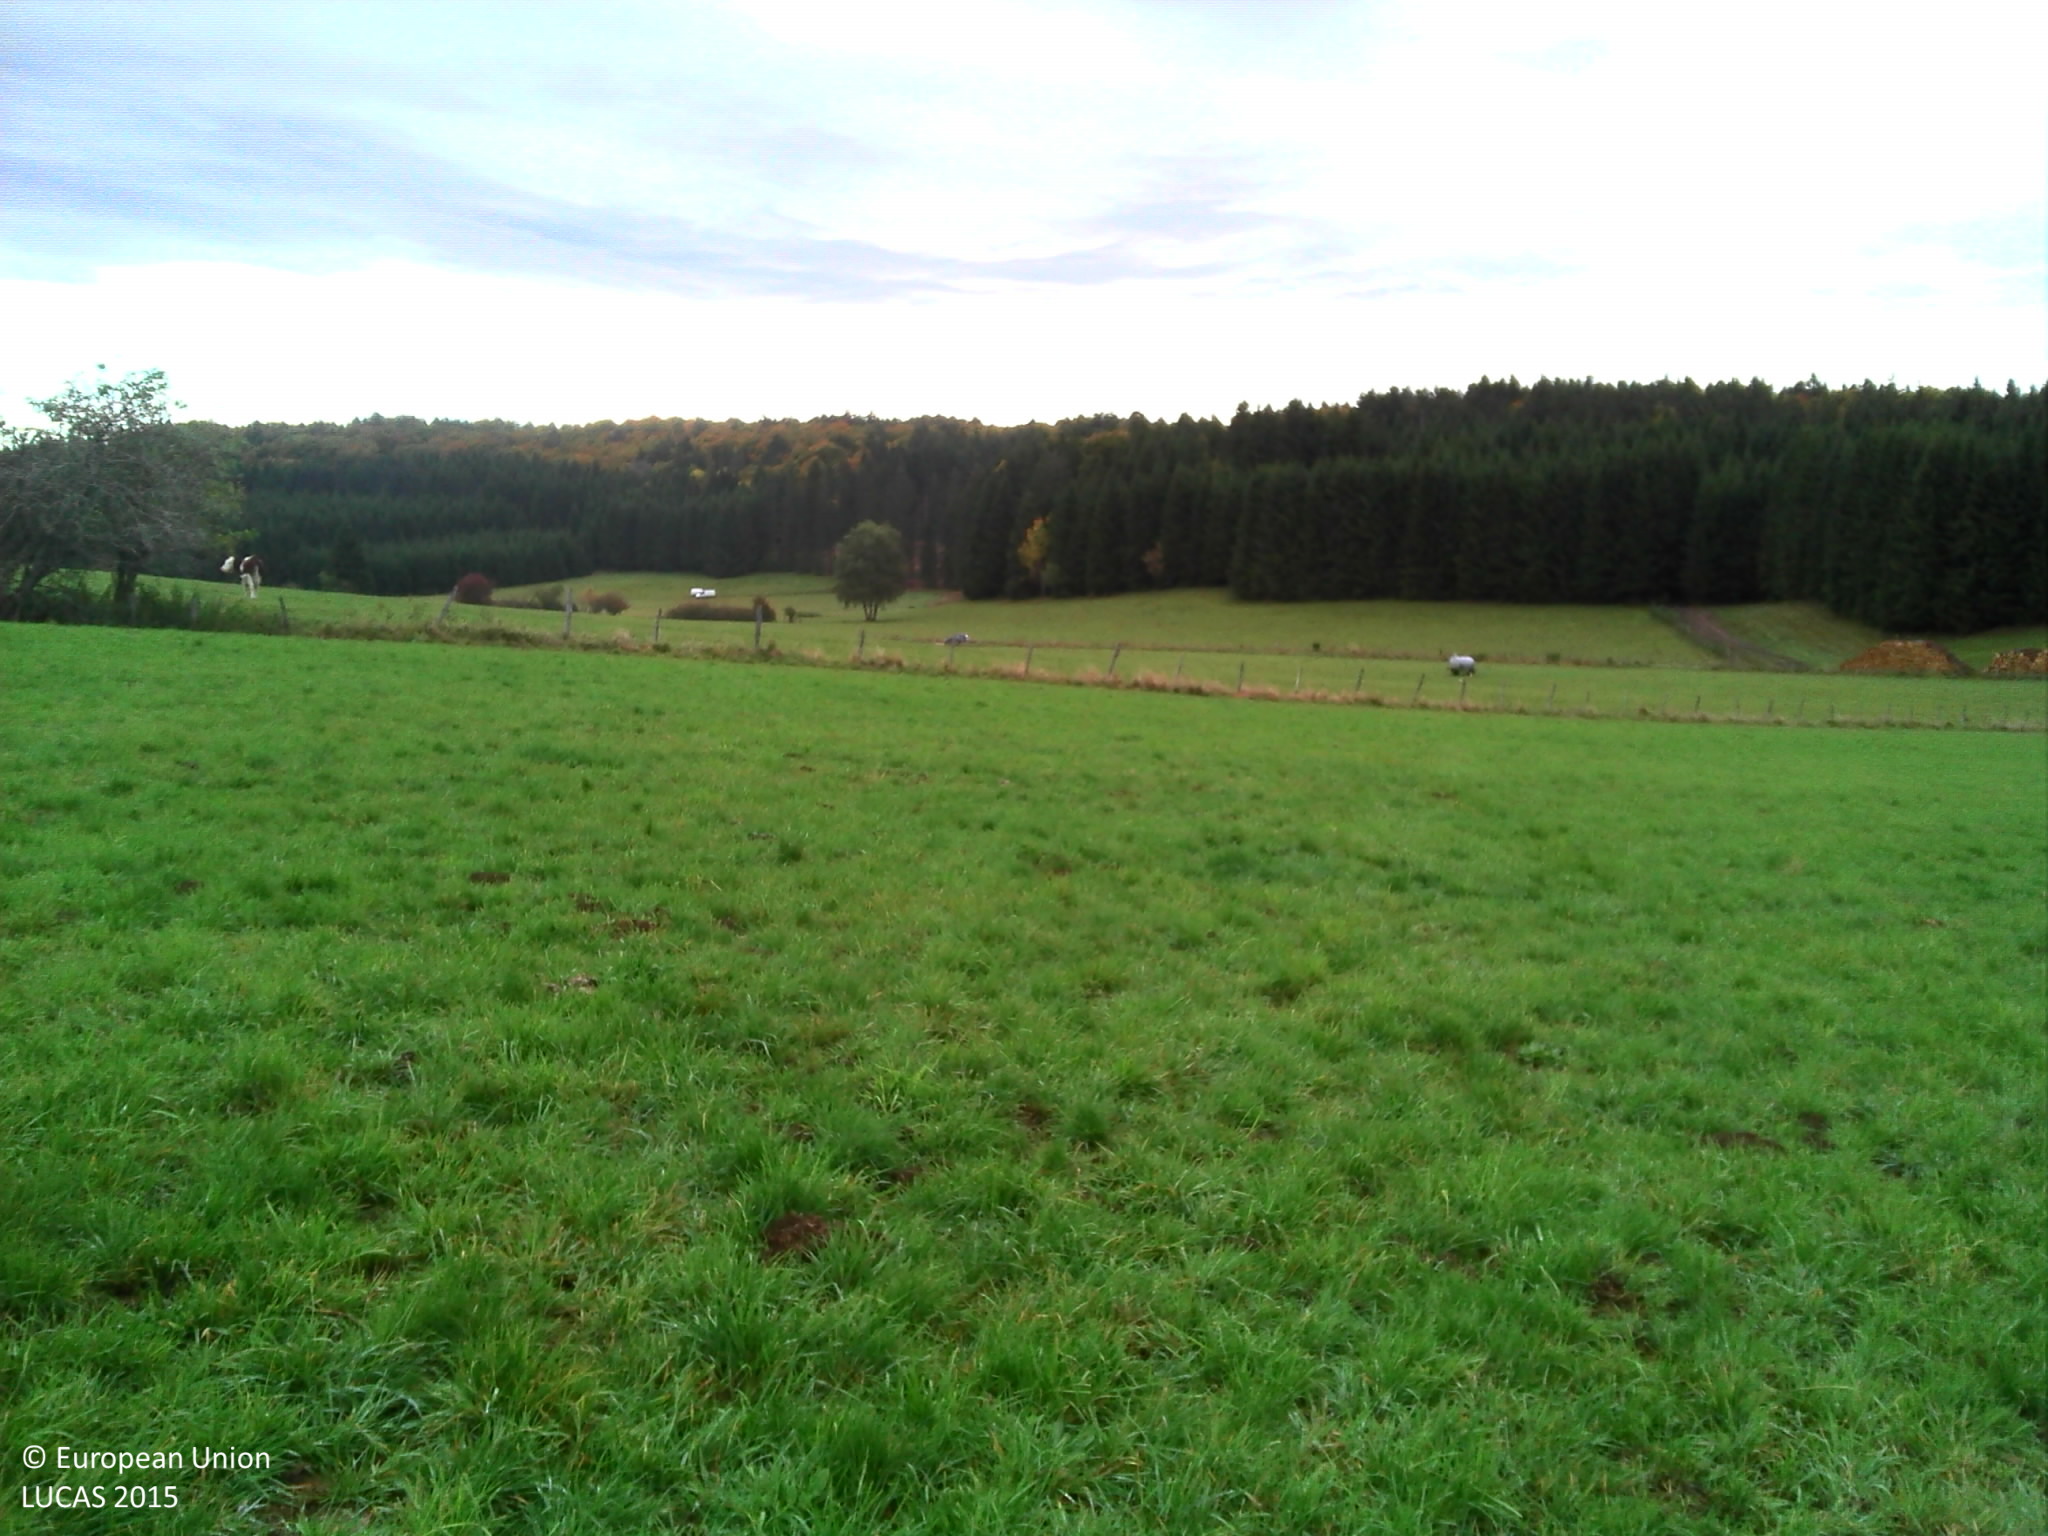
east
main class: Grassland
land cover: Grassland without tree/shrub cover
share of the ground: > 75 %
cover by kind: herbaceous plants 100 %
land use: Agriculture (excluding fallow land and kitchen gardens)
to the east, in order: Grassland without tree/shrub cover; Fences; Grassland without tree/shrub cover; Fences; Grassland without tree/shrub cover
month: October
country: FR
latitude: 46.9357
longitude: 6.2850
